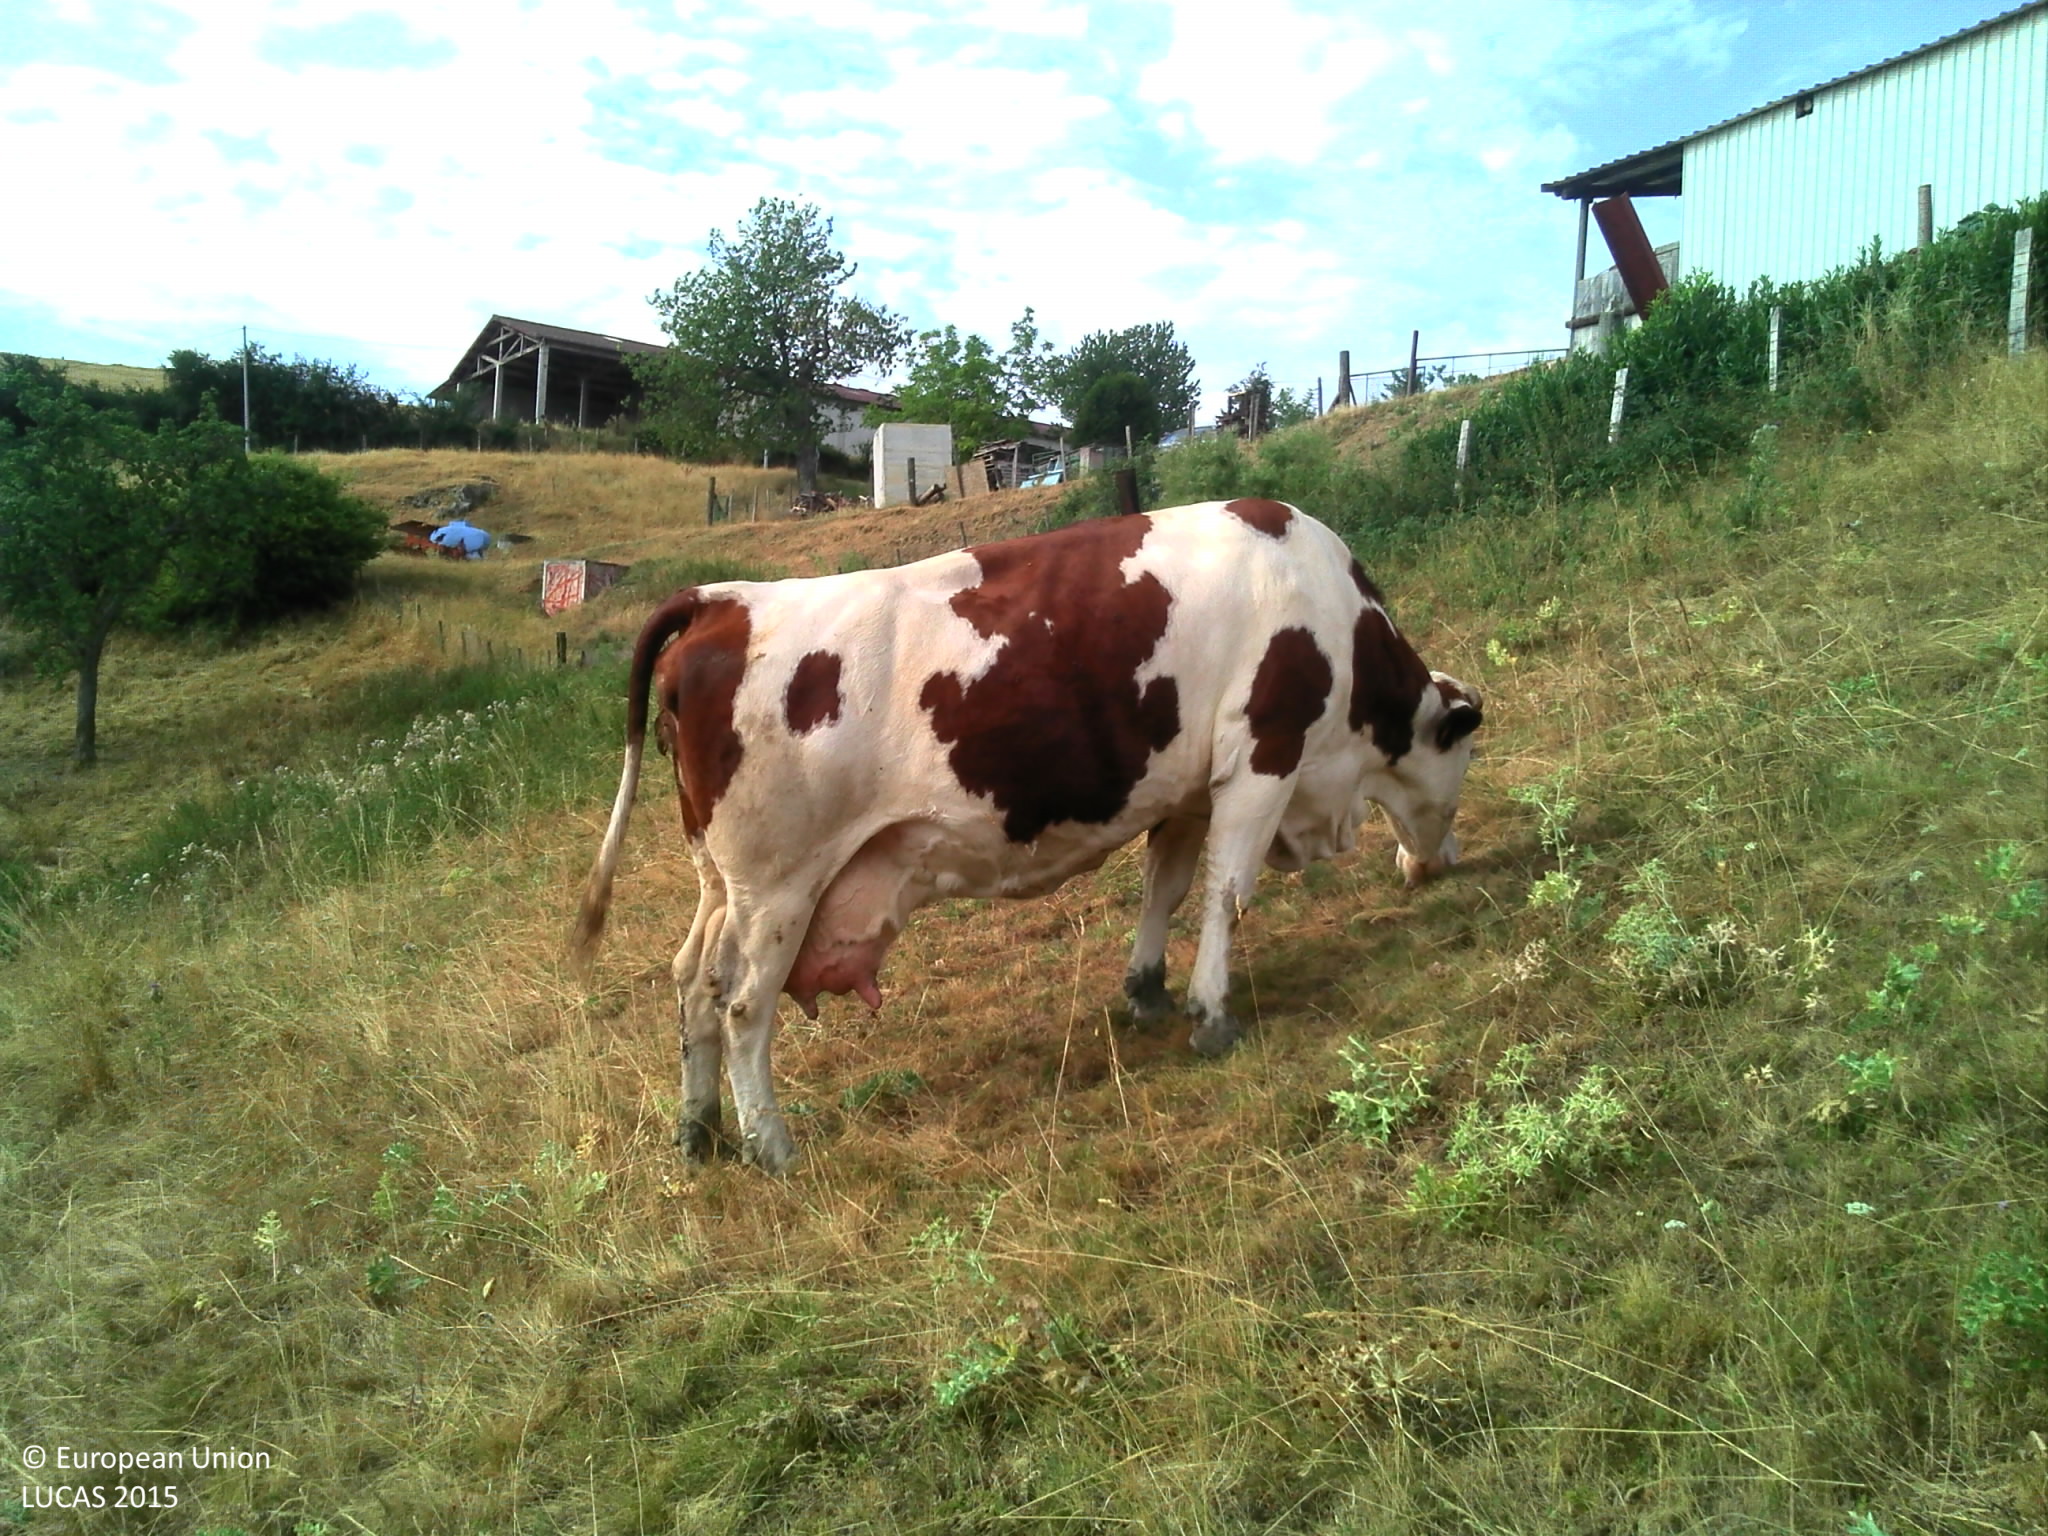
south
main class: Grassland
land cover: Grassland without tree/shrub cover
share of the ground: > 75 %
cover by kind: herbaceous plants 100 %
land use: Agriculture (excluding fallow land and kitchen gardens)
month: July
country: FR
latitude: 45.9014
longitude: 4.4731
